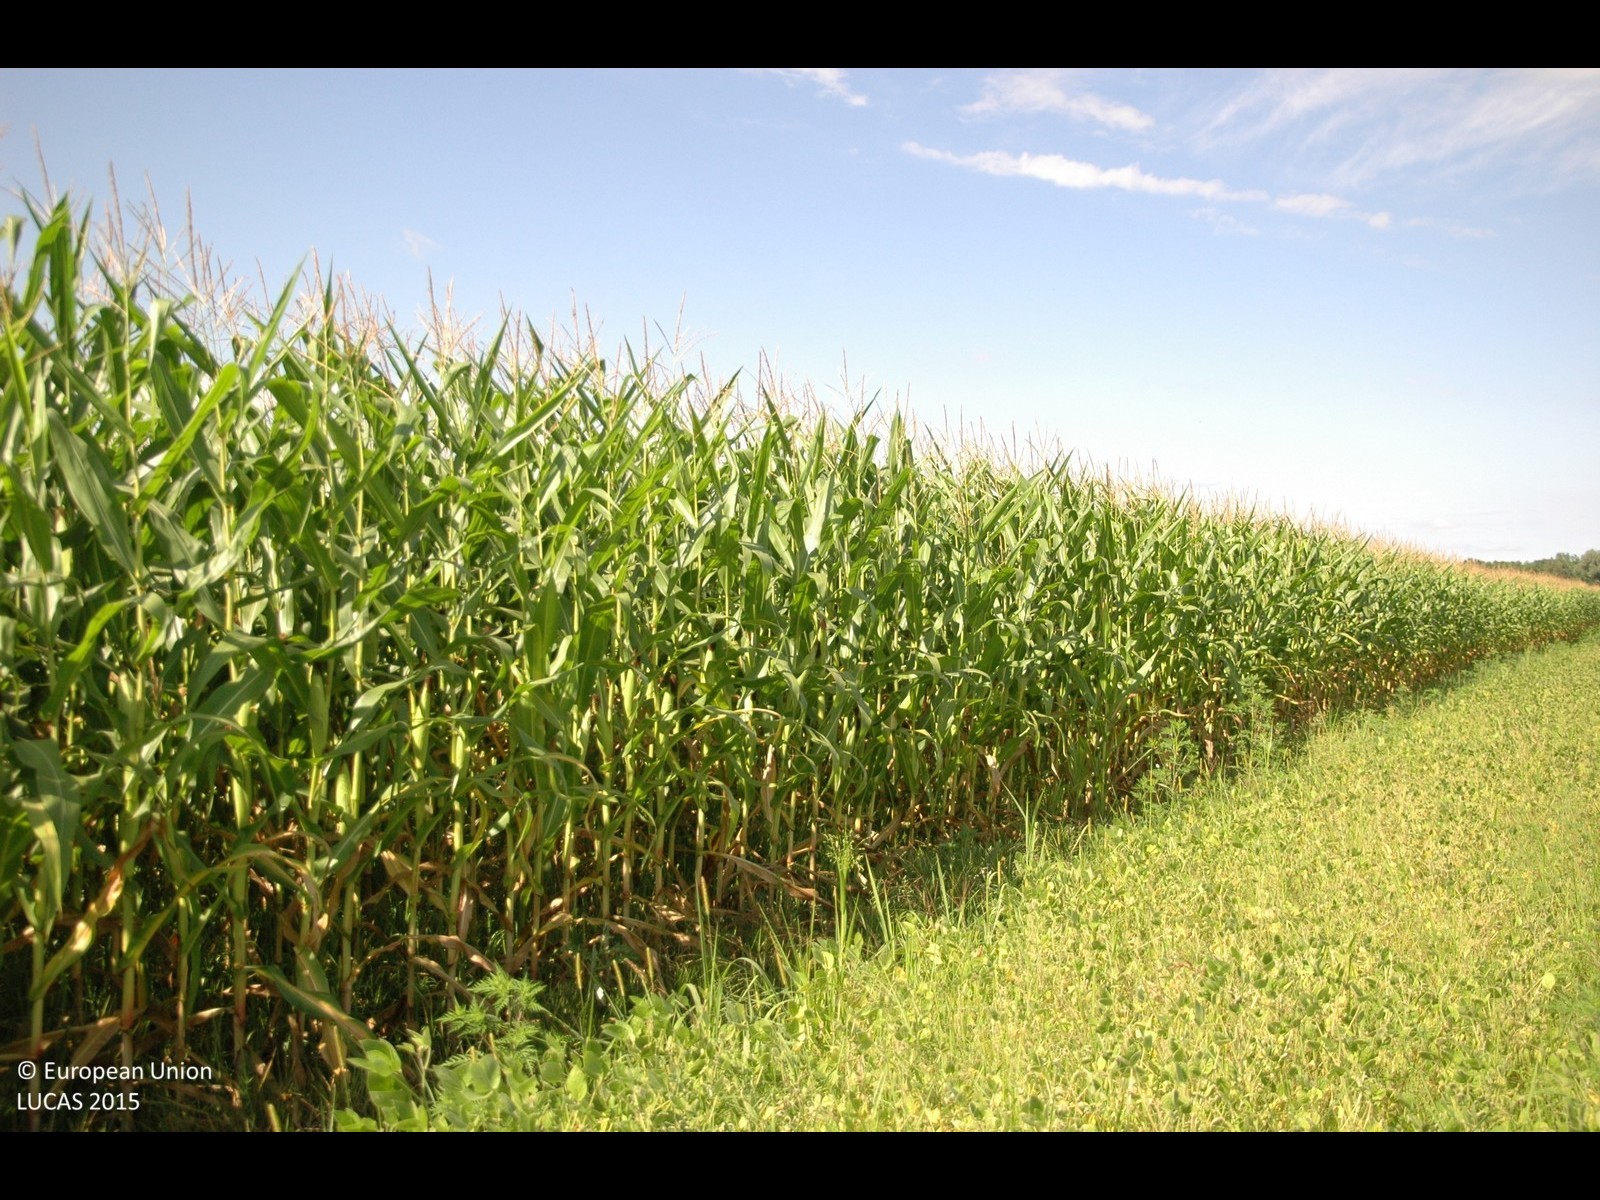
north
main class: Cropland
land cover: Soya
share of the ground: > 75 %
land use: Agriculture (excluding fallow land and kitchen gardens)
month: July
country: HR
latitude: 46.2132
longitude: 16.7025
